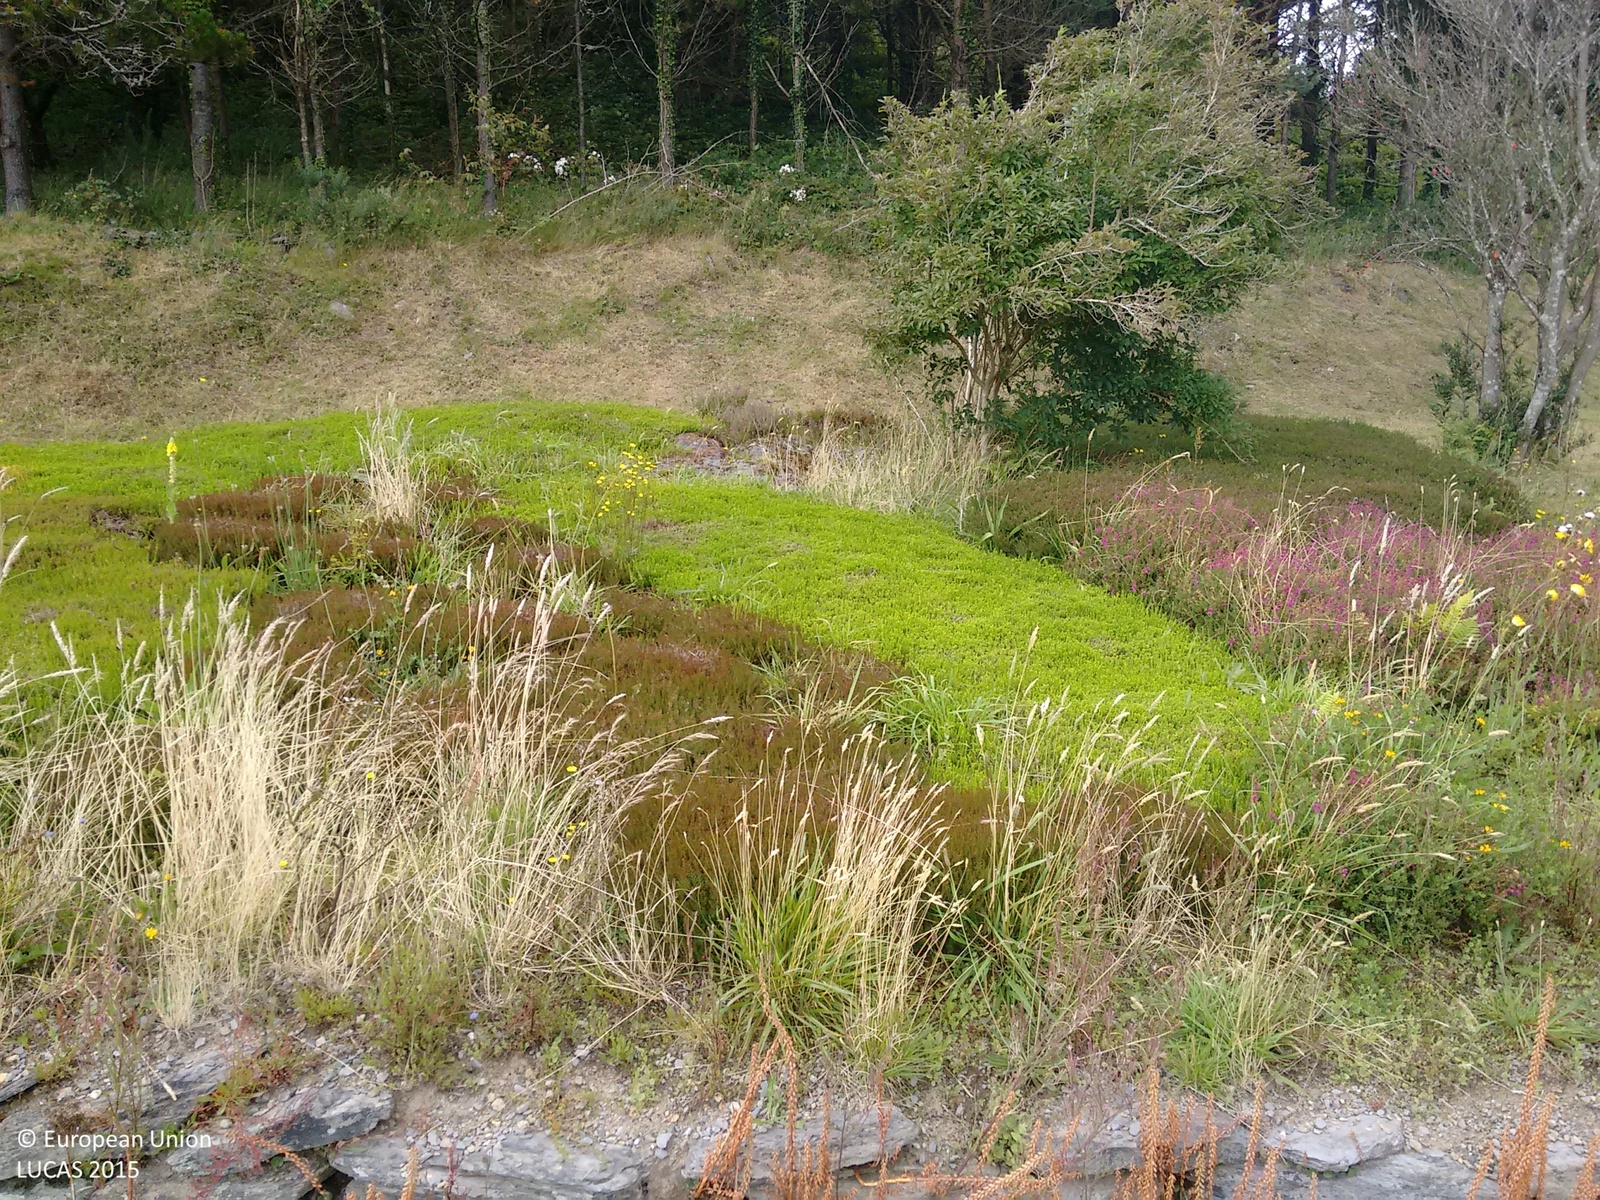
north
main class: Grassland
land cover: Grassland without tree/shrub cover
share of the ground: > 75 %
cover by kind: herbaceous plants 80 %
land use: Residential
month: July
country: IE
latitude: 51.5510
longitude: -9.3947
